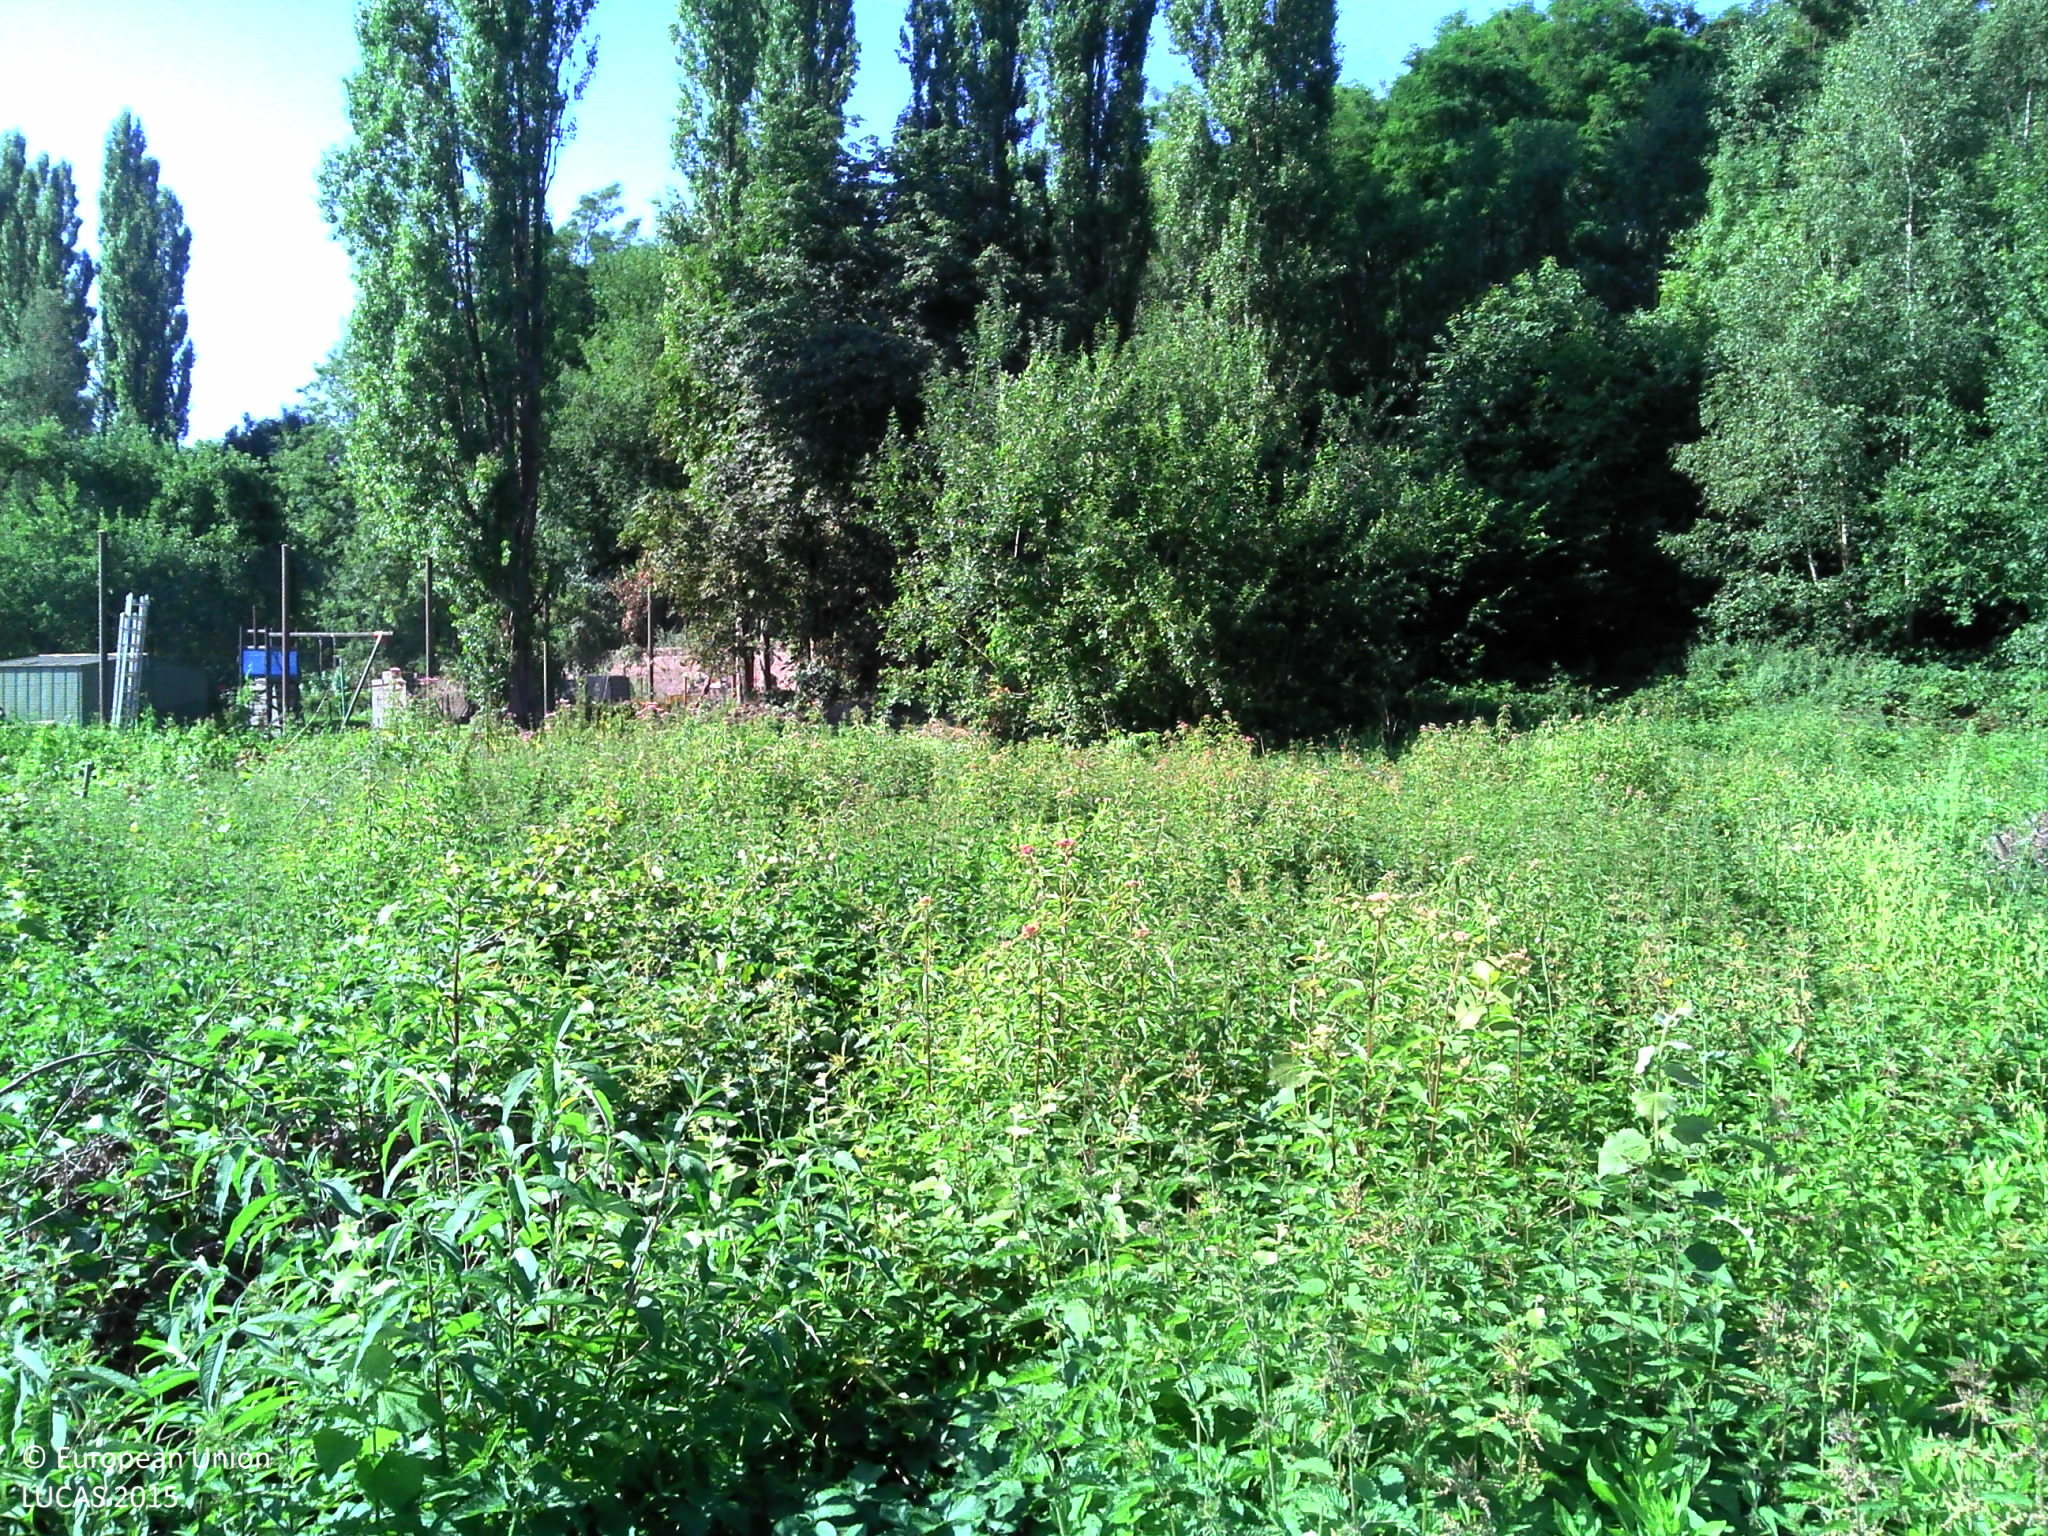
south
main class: Grassland
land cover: Spontaneously vegetated surfaces
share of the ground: > 75 %
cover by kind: herbaceous plants 95 %, shrubs 5 %
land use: Semi-natural and natural areas not in use
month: August
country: BE
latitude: 50.4144
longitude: 4.5498
